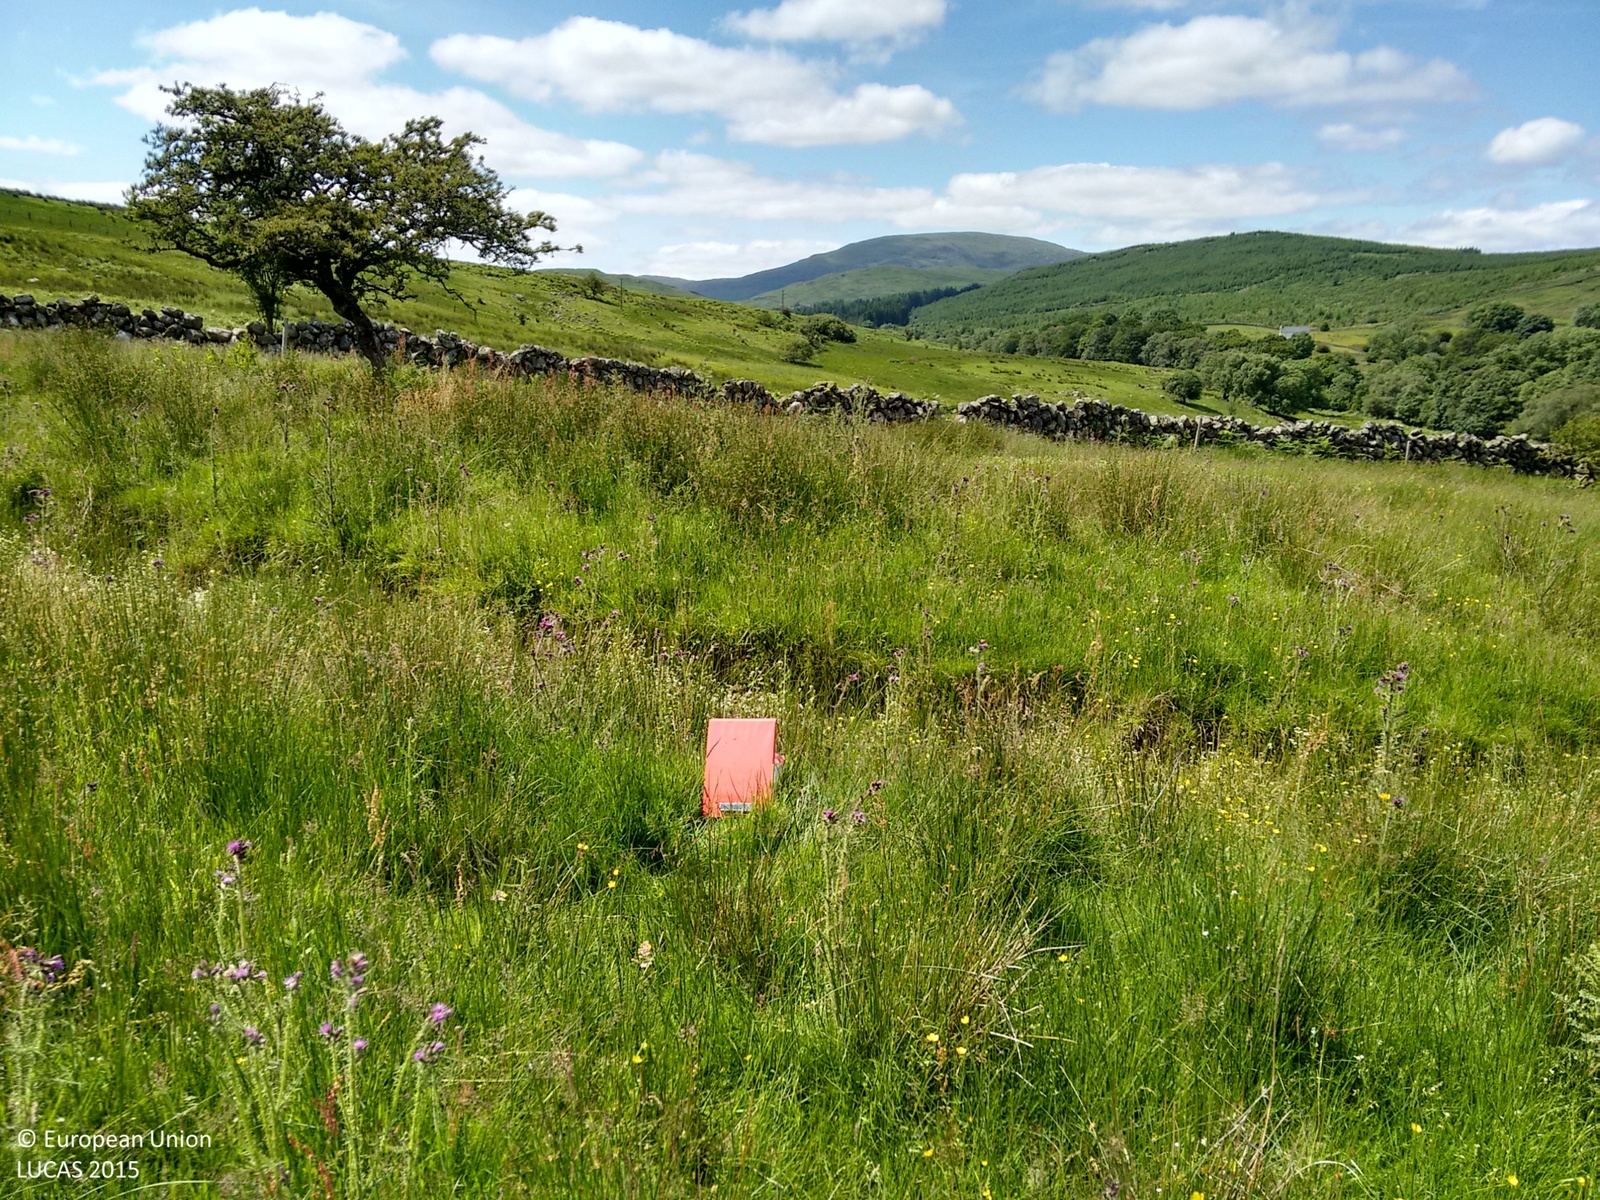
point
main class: Grassland
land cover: Grassland without tree/shrub cover
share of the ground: > 75 %
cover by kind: herbaceous plants 100 %
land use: Agriculture (excluding fallow land and kitchen gardens)
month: July
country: GB
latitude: 55.1157
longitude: -4.2212
